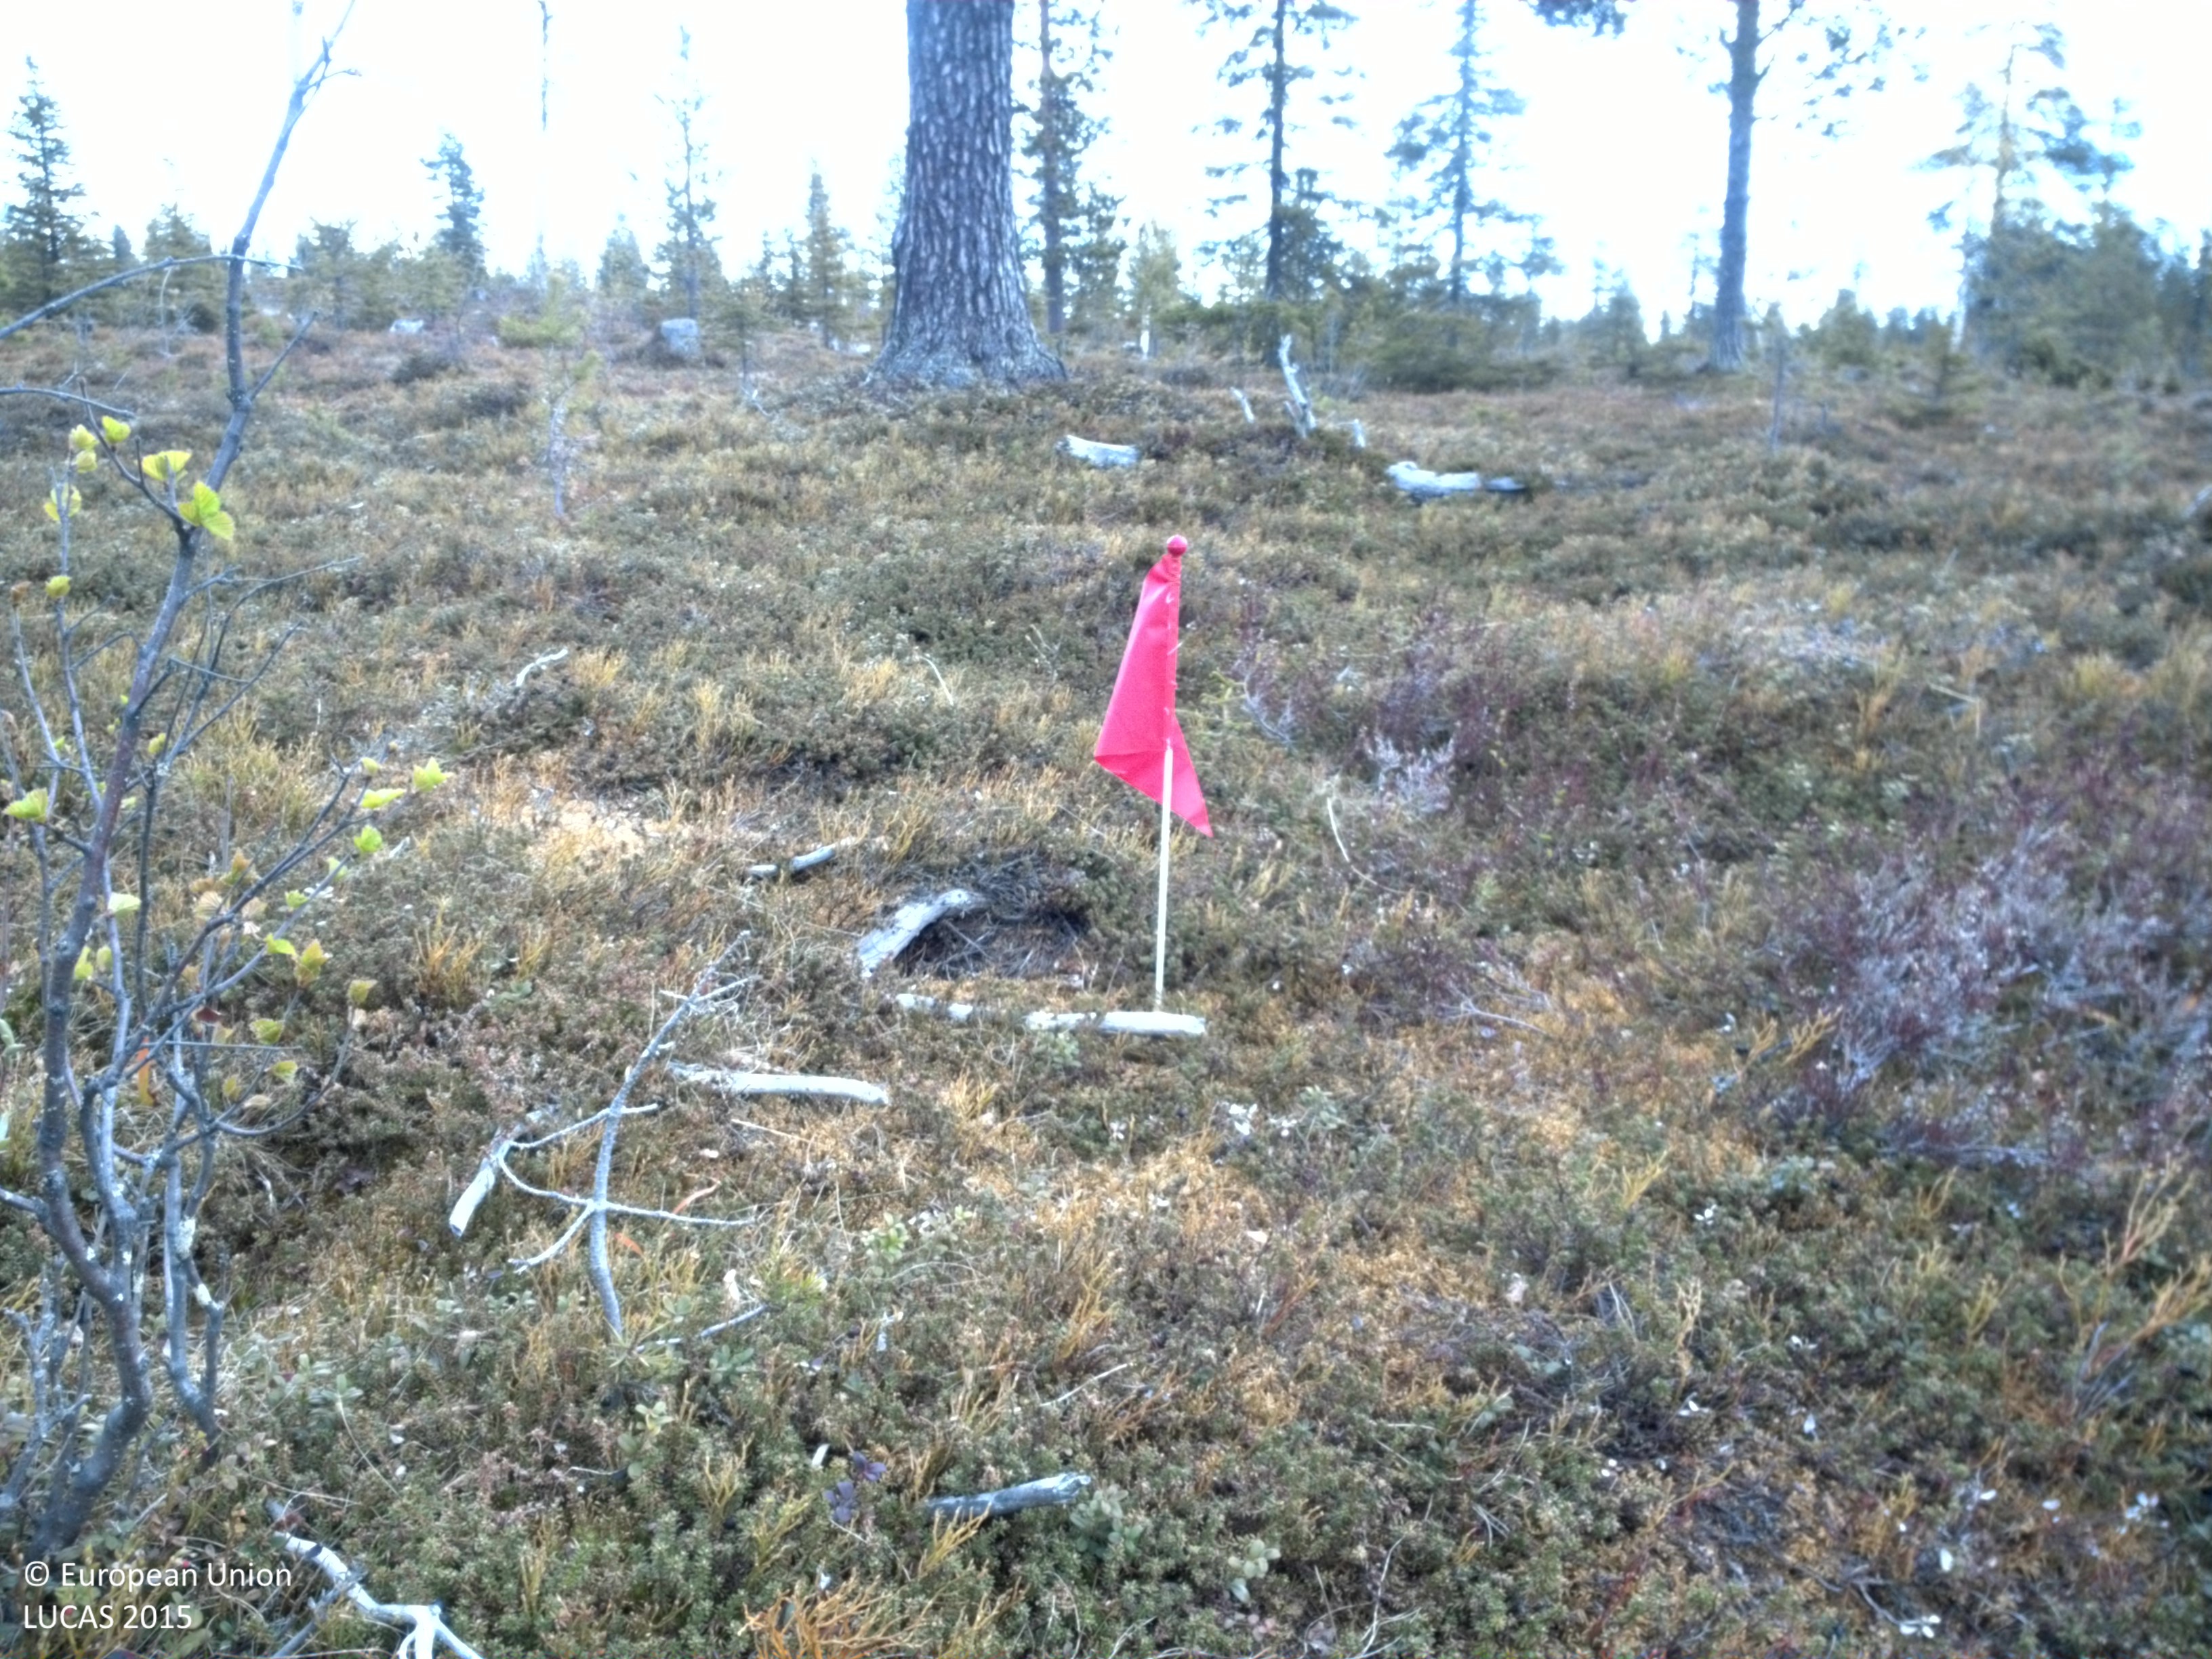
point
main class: Woodland
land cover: Pine dominated coniferous woodland
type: boreal forest
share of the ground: 10 - 25 %
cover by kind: herbaceous plants 75 %, coniferous forest trees 15 %, broadleaved forest trees 5 %, shrubs 5 %
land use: Forestry
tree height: > 5 m
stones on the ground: < 10 %
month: June
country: SE
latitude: 67.0157
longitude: 20.9914
